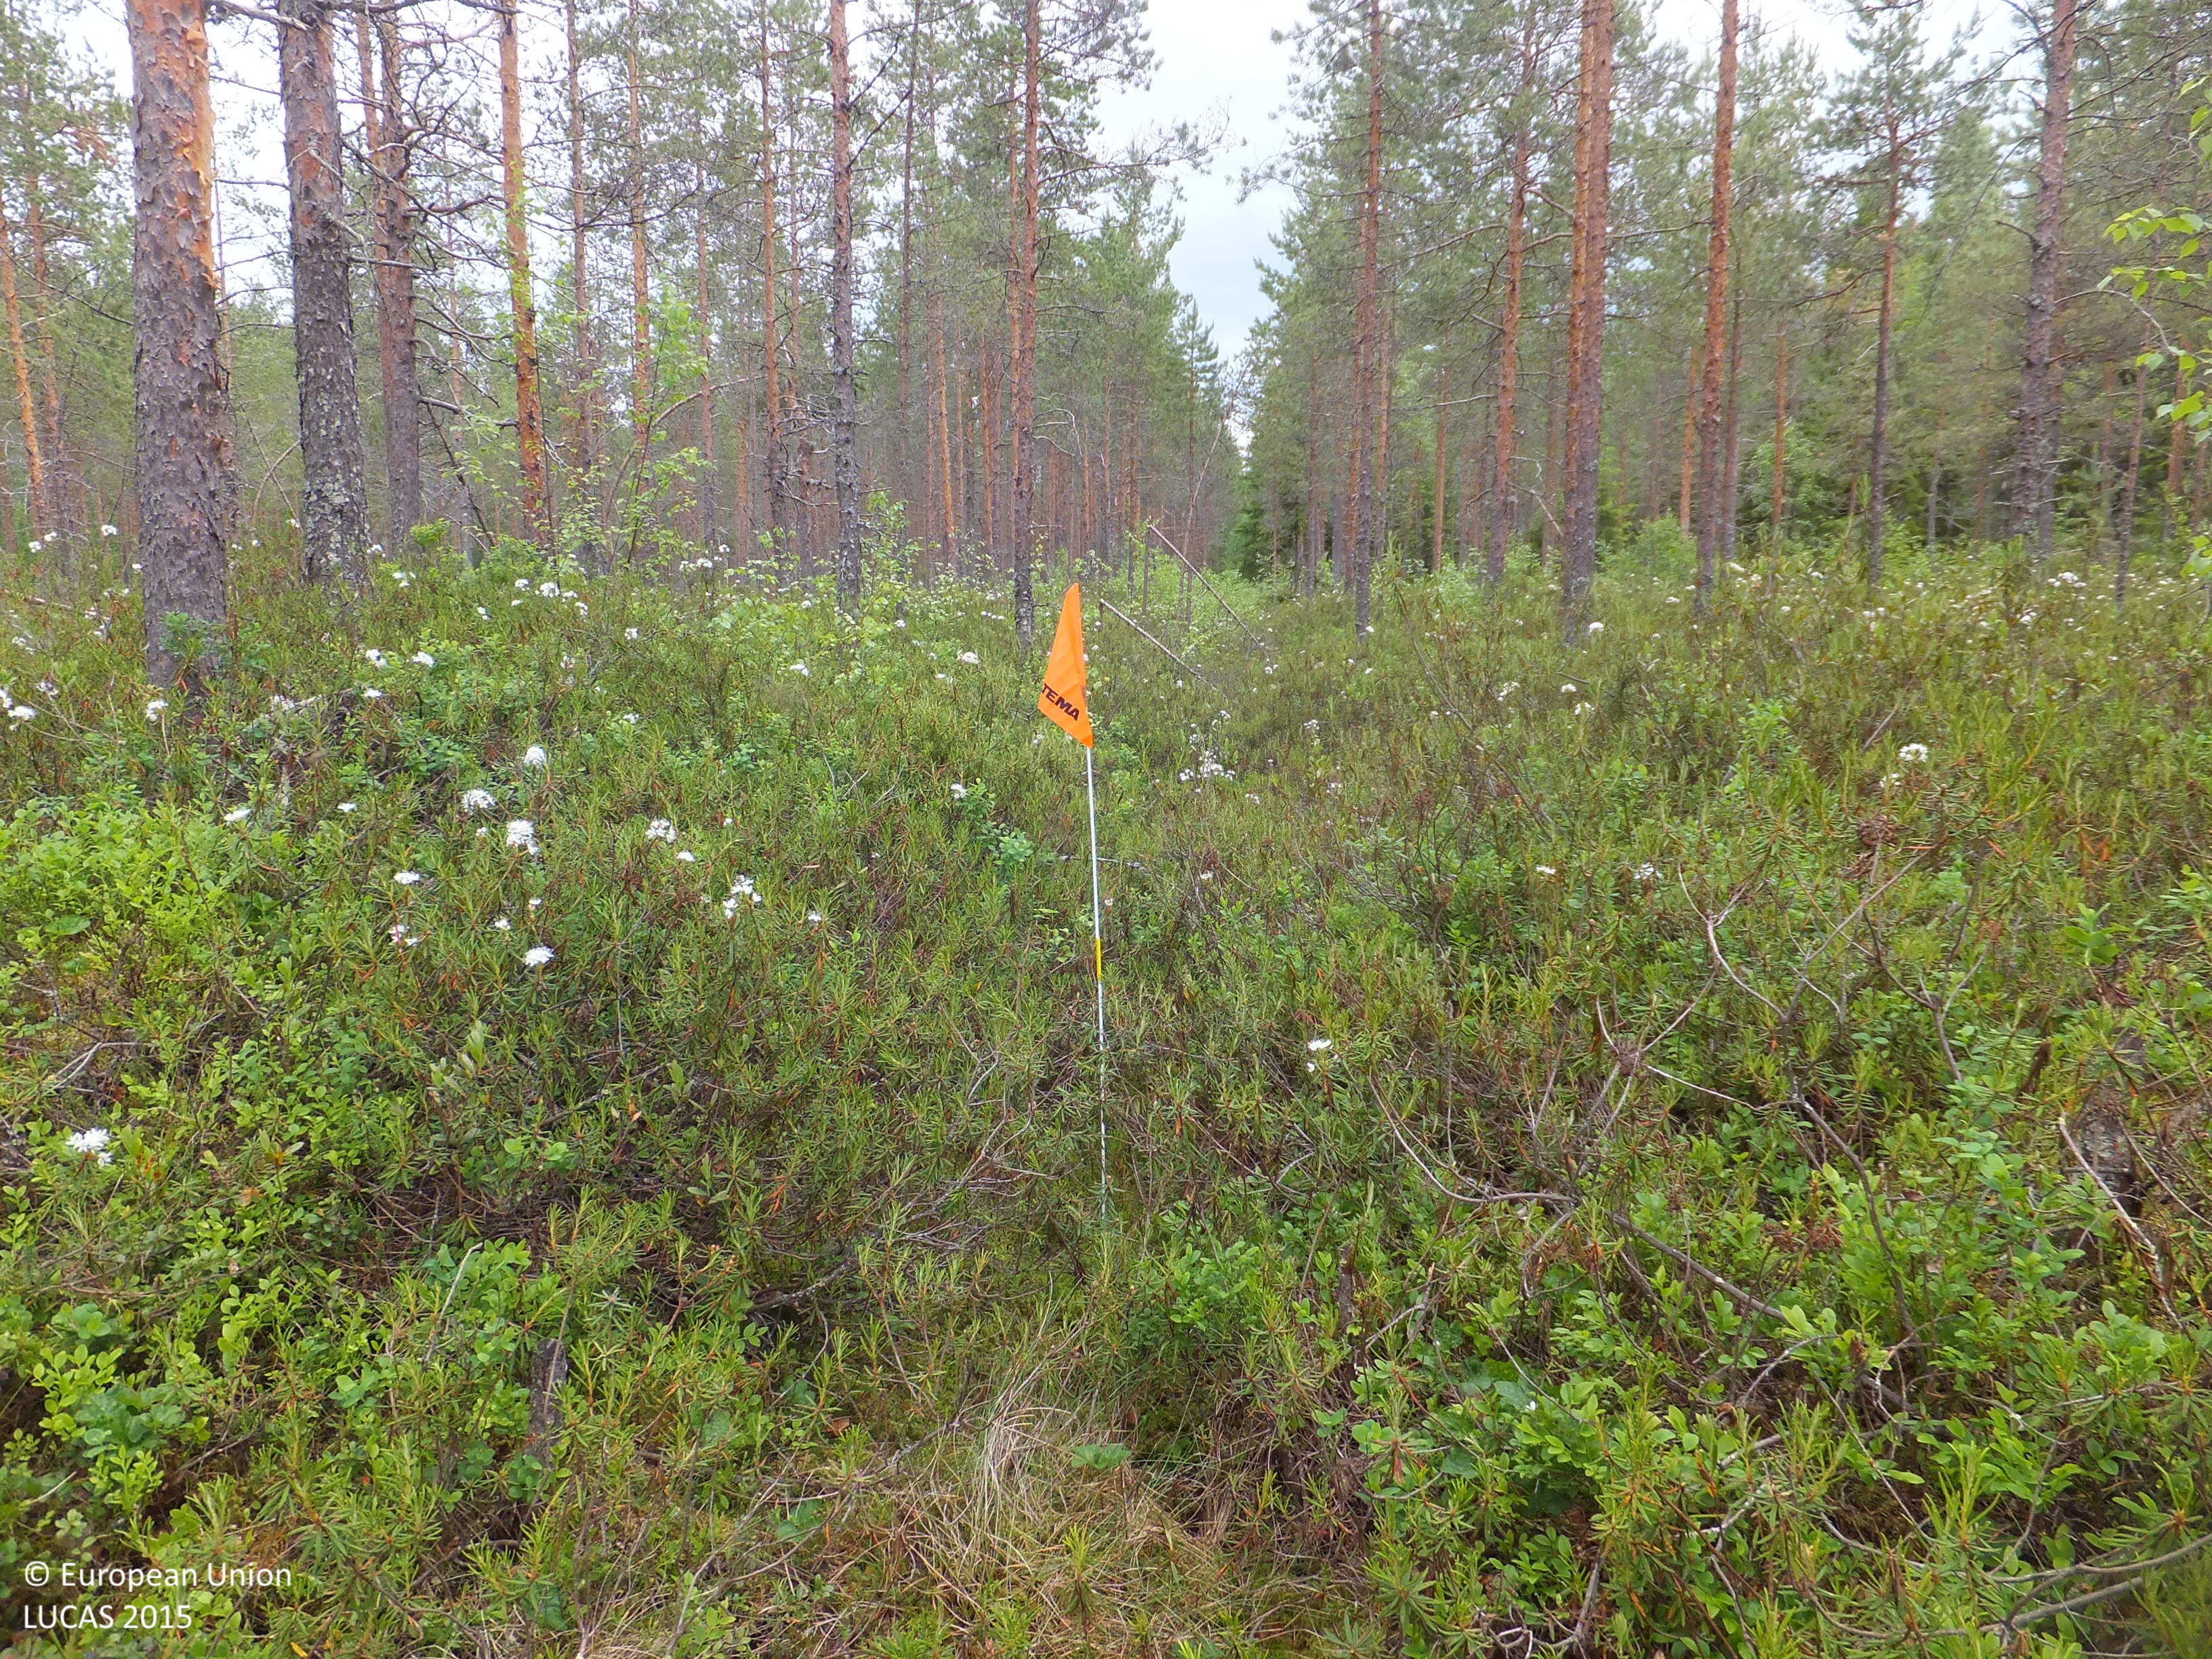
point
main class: Woodland
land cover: Pine dominated mixed woodland
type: boreal forest
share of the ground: 50 - 75 %
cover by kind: coniferous forest trees 40 %, shrubs 30 %, broadleaved forest trees 25 %, lichens and mosses 5 %
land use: Forestry
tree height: > 5 m
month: June
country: FI
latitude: 63.5193
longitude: 24.1644
